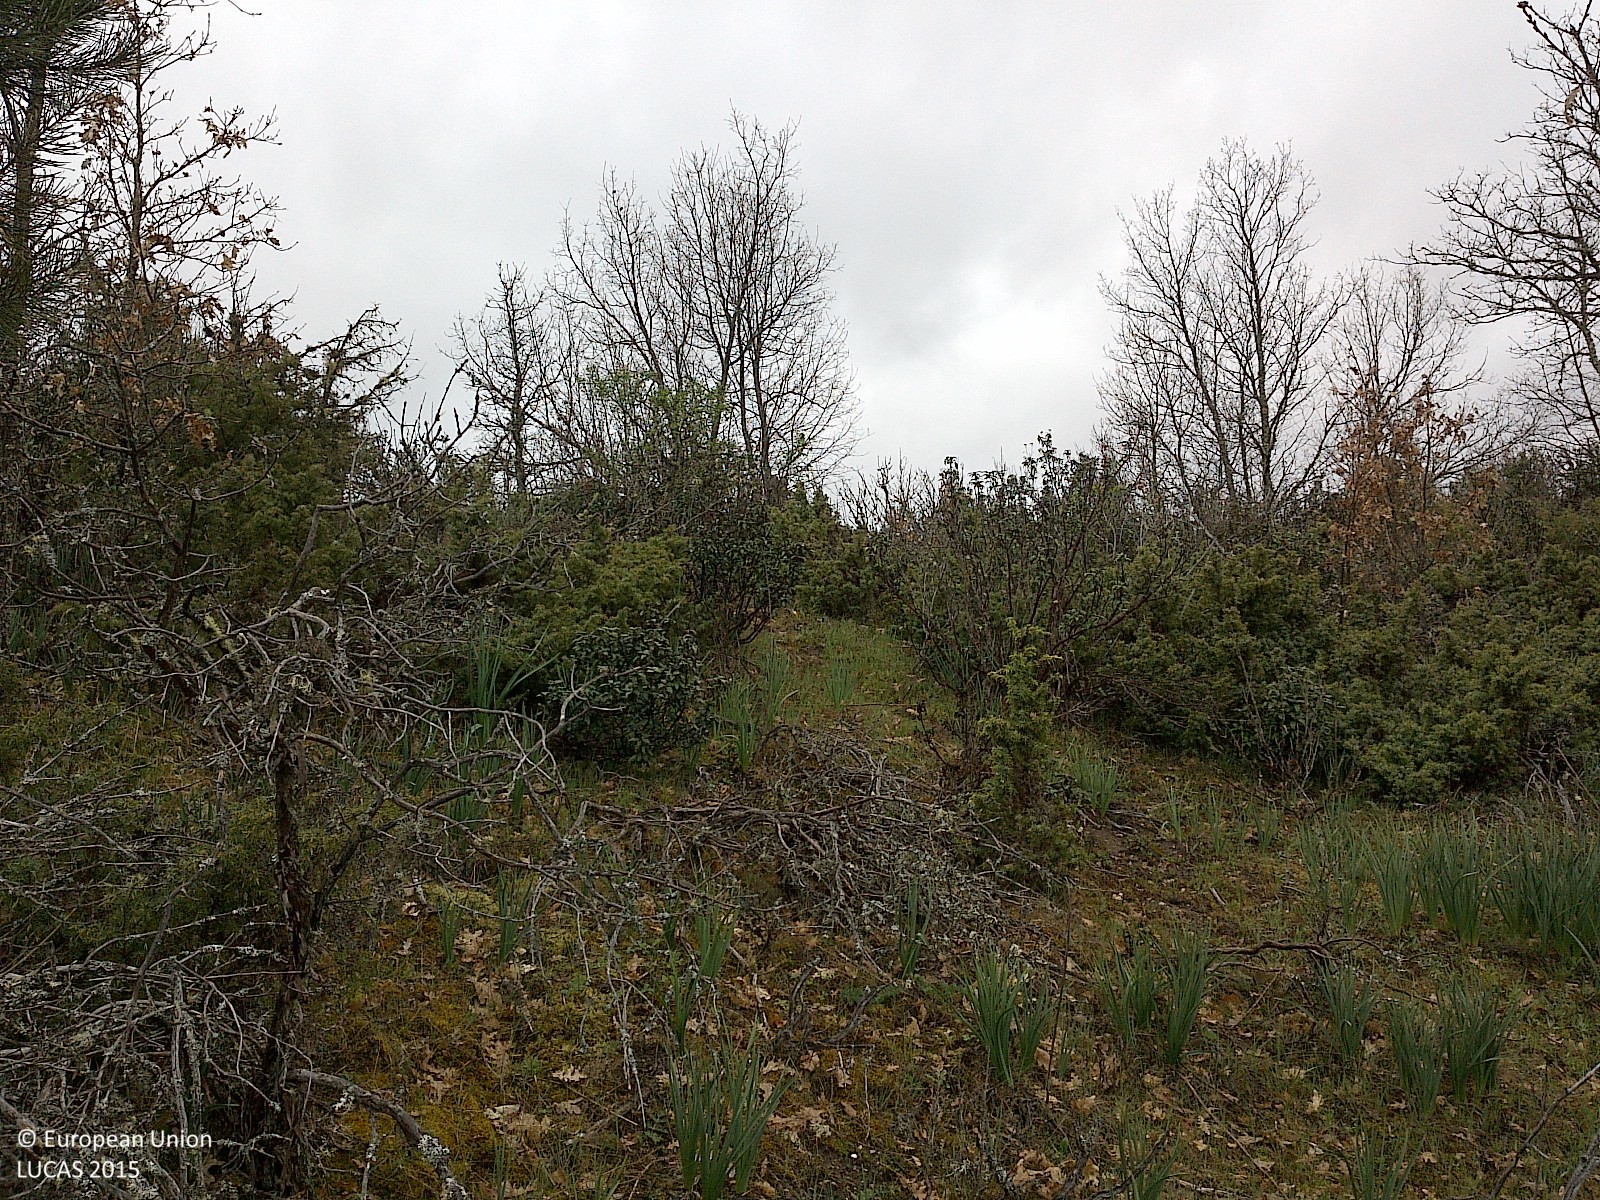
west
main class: Woodland
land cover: Broadleaved woodland
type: thermophilous deciduous forest
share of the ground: 25 - 50 %
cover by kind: shrubs 40 %, broadleaved forest trees 30 %, consolidated bare surface 15 %, herbaceous plants 10 %, coniferous forest trees 5 %
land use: Semi-natural and natural areas not in use
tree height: < 5 m
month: May
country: ES
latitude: 41.9345
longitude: -3.1825
